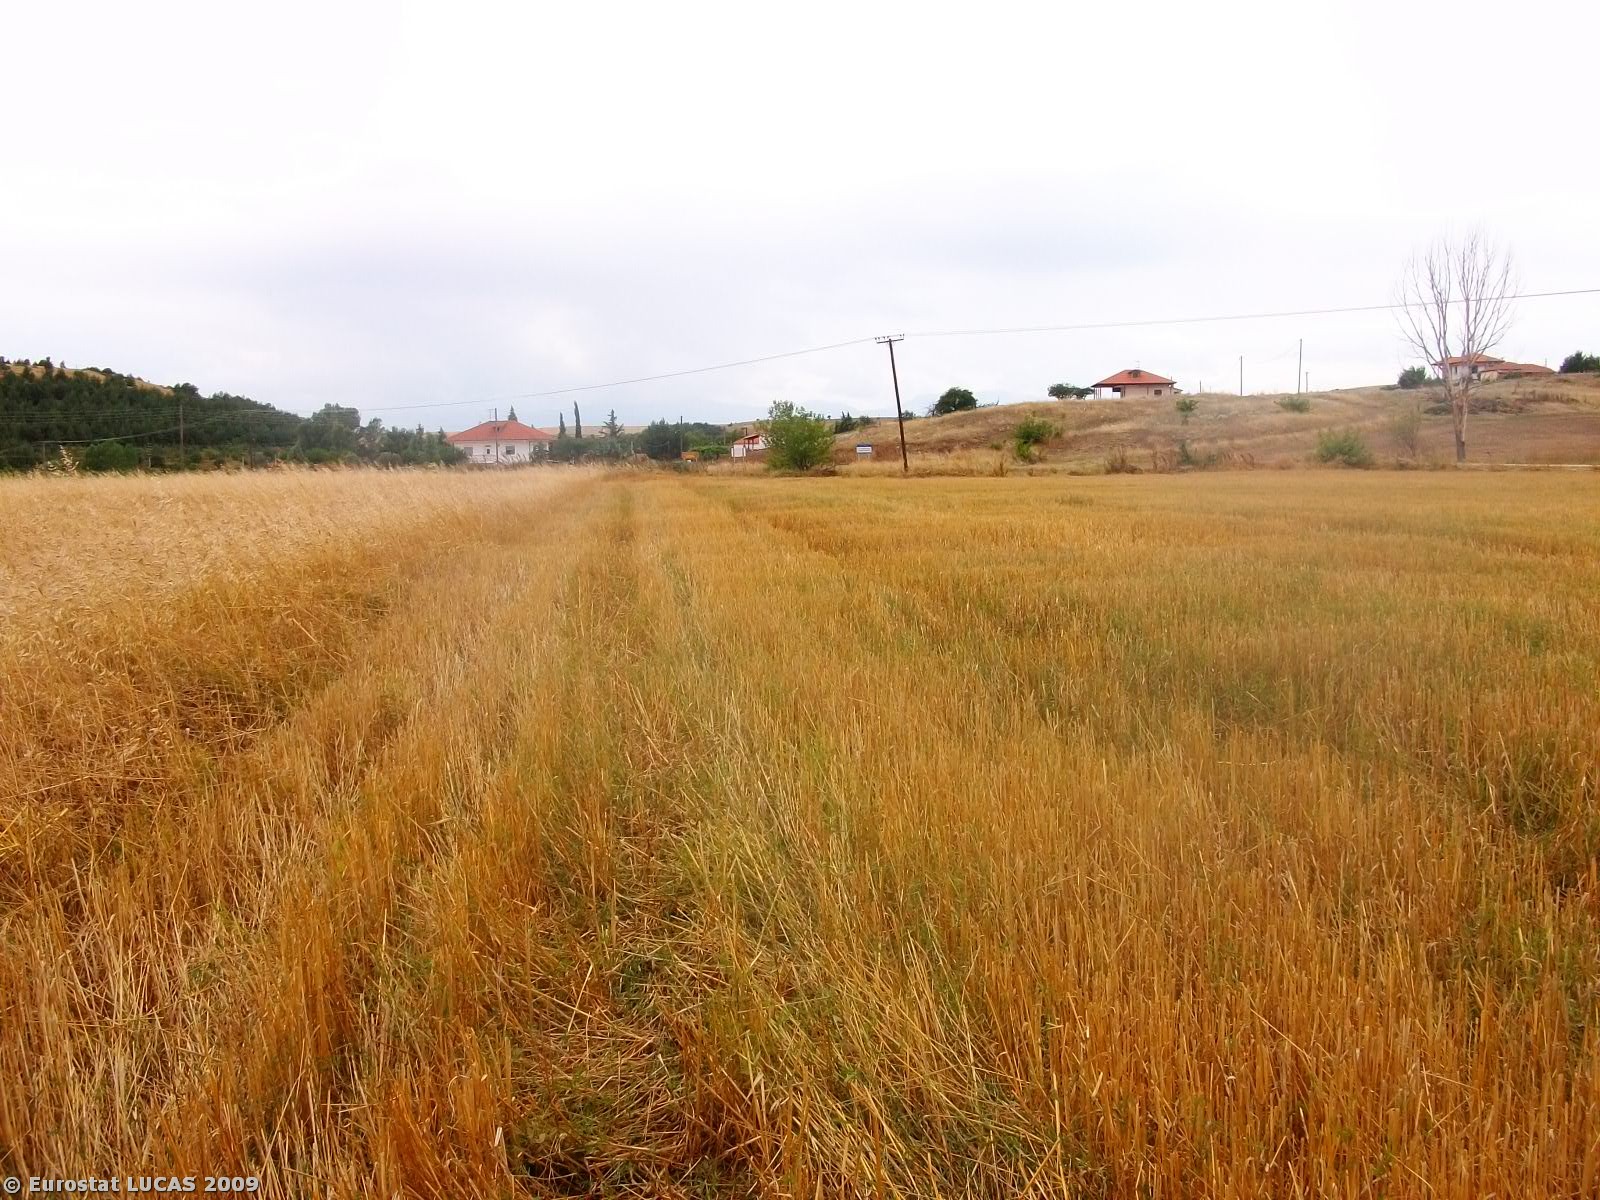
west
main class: Cropland
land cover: Durum wheat
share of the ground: > 75 %
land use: Agriculture (excluding fallow land and kitchen gardens)
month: June
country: GR
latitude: 40.9488
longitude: 22.7550
